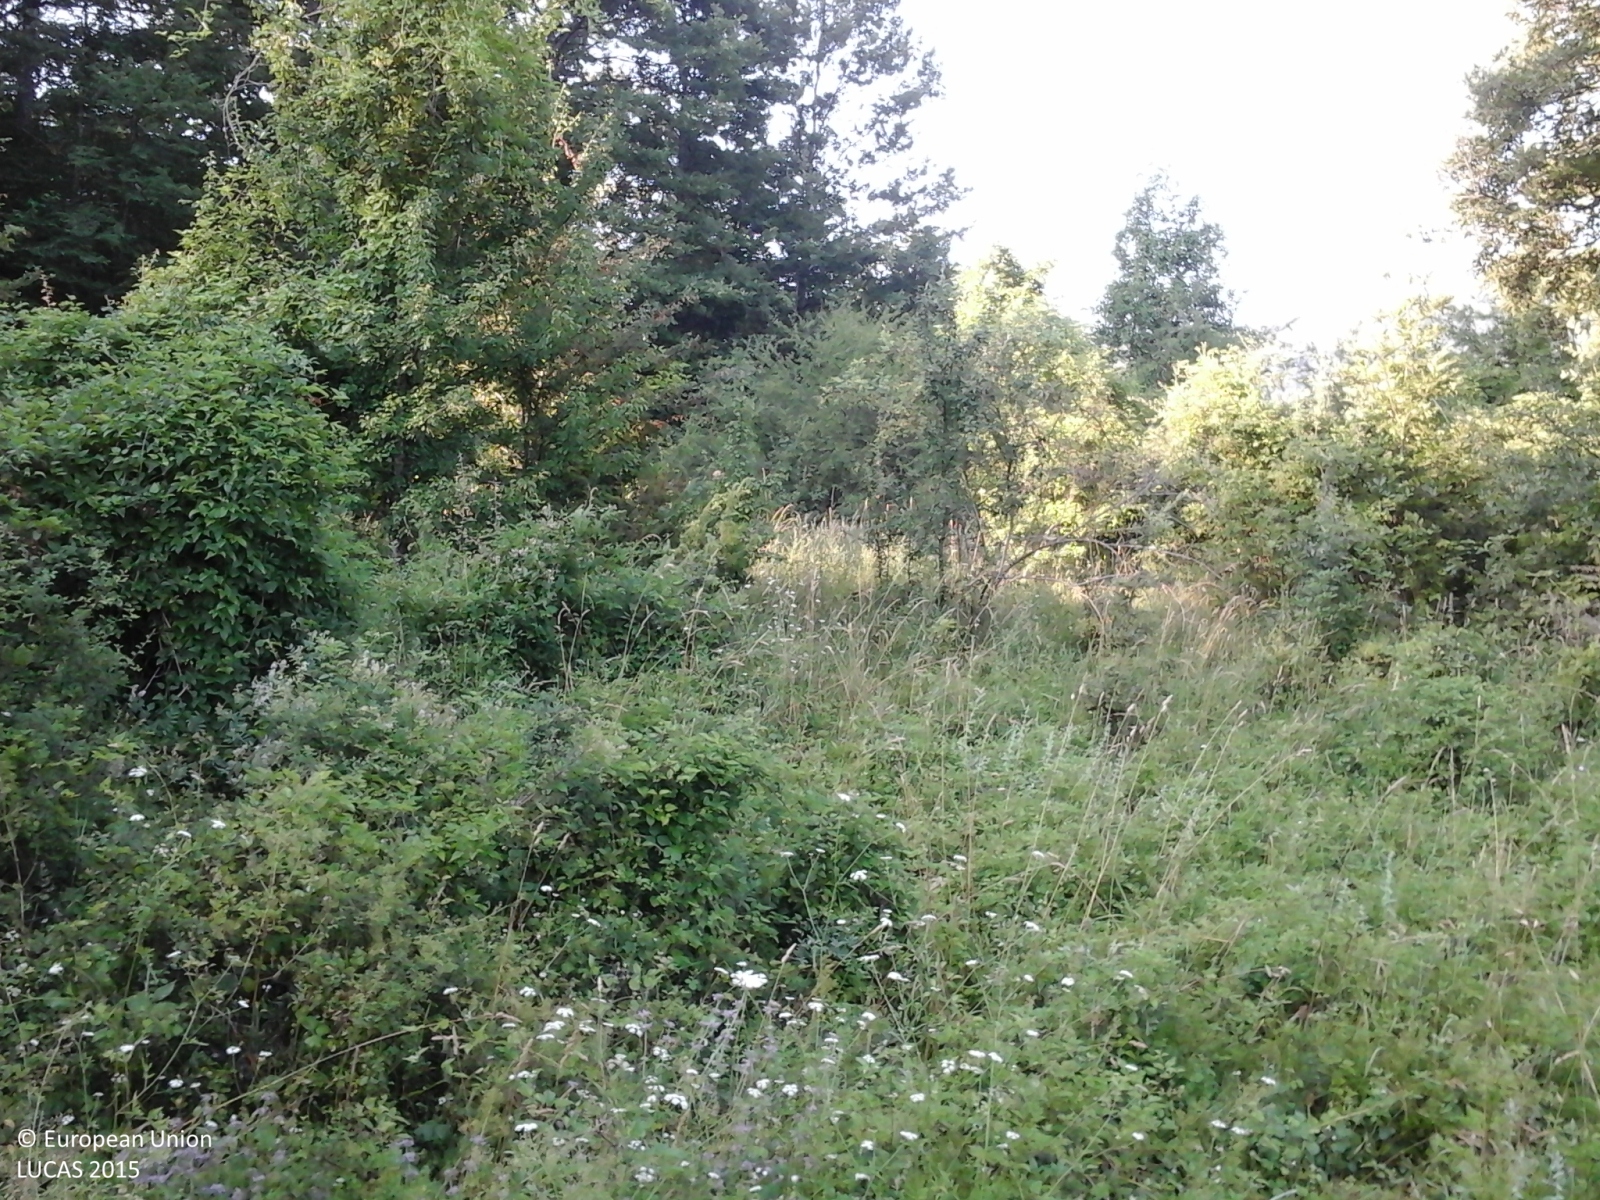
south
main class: Woodland
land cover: Broadleaved woodland
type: mesophytic deciduous forest
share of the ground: > 75 %
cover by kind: broadleaved forest trees 100 %
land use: Forestry
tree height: > 5 m
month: July
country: IT
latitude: 43.7520
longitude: 12.0936
